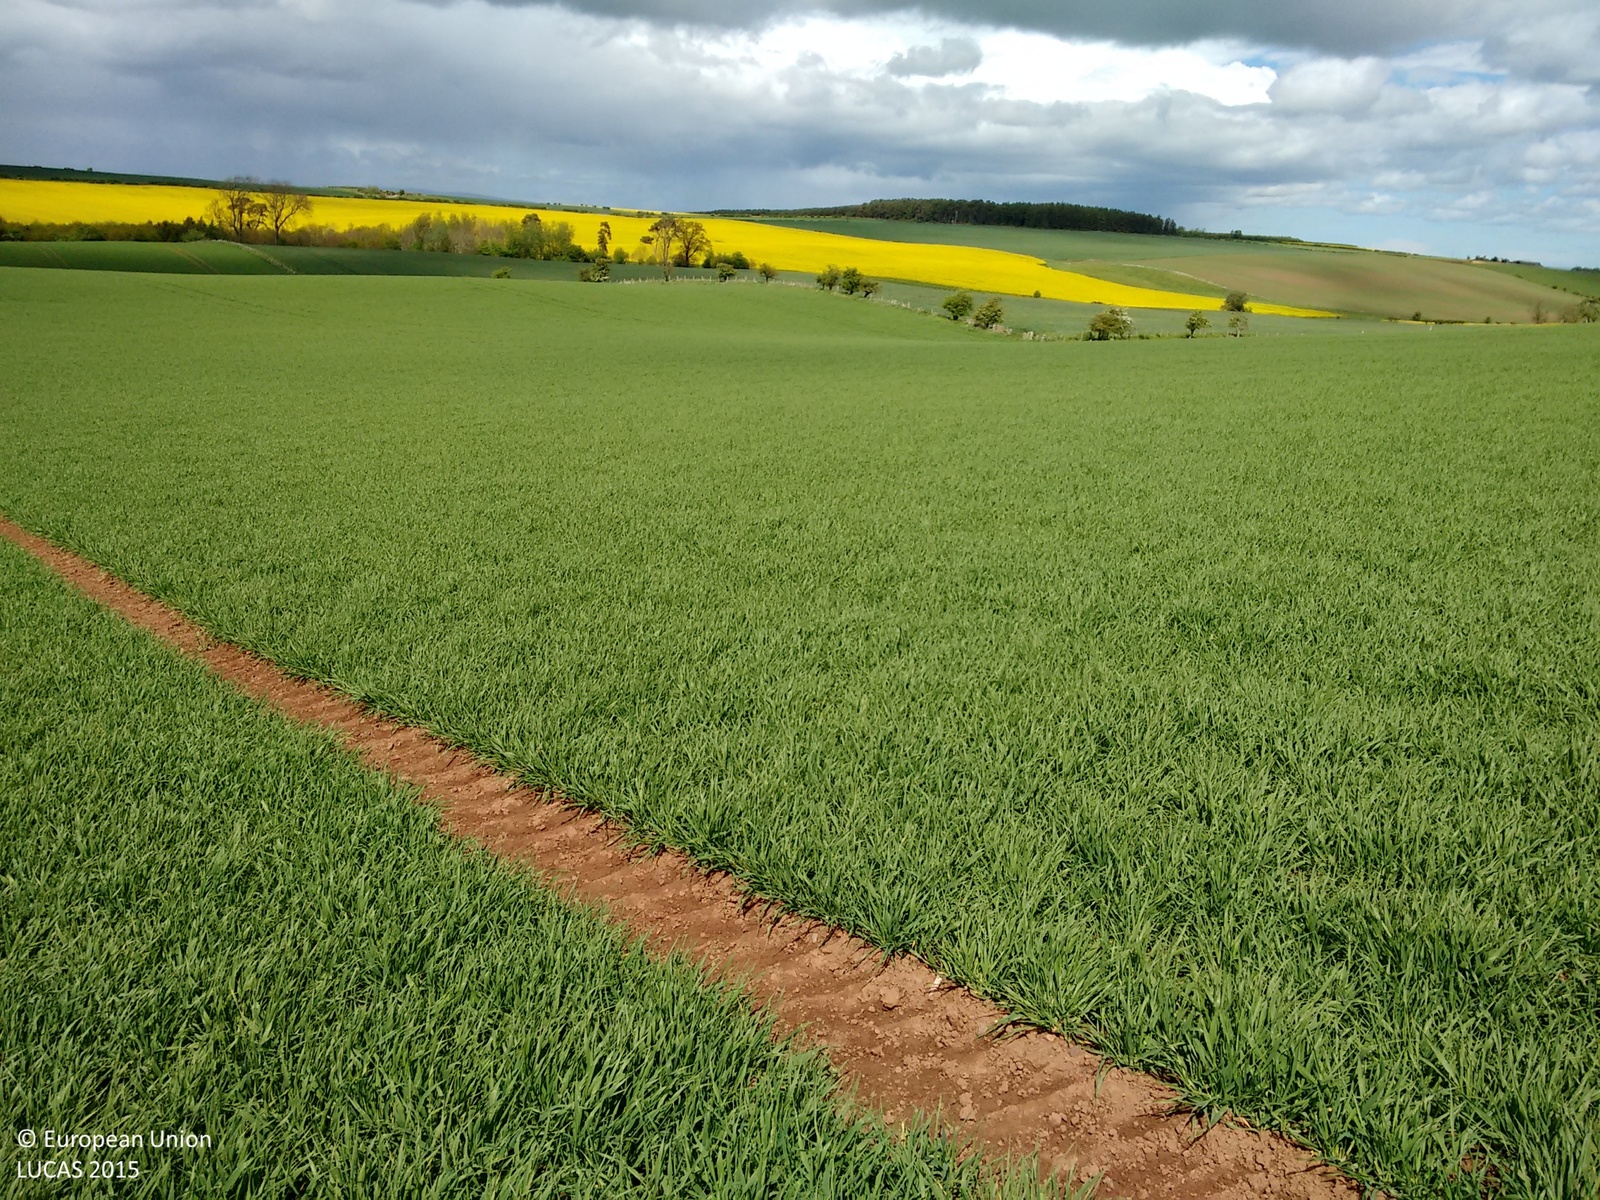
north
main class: Cropland
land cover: Barley
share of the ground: > 75 %
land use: Agriculture (excluding fallow land and kitchen gardens)
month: May
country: GB
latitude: 55.5879
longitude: -2.3546
